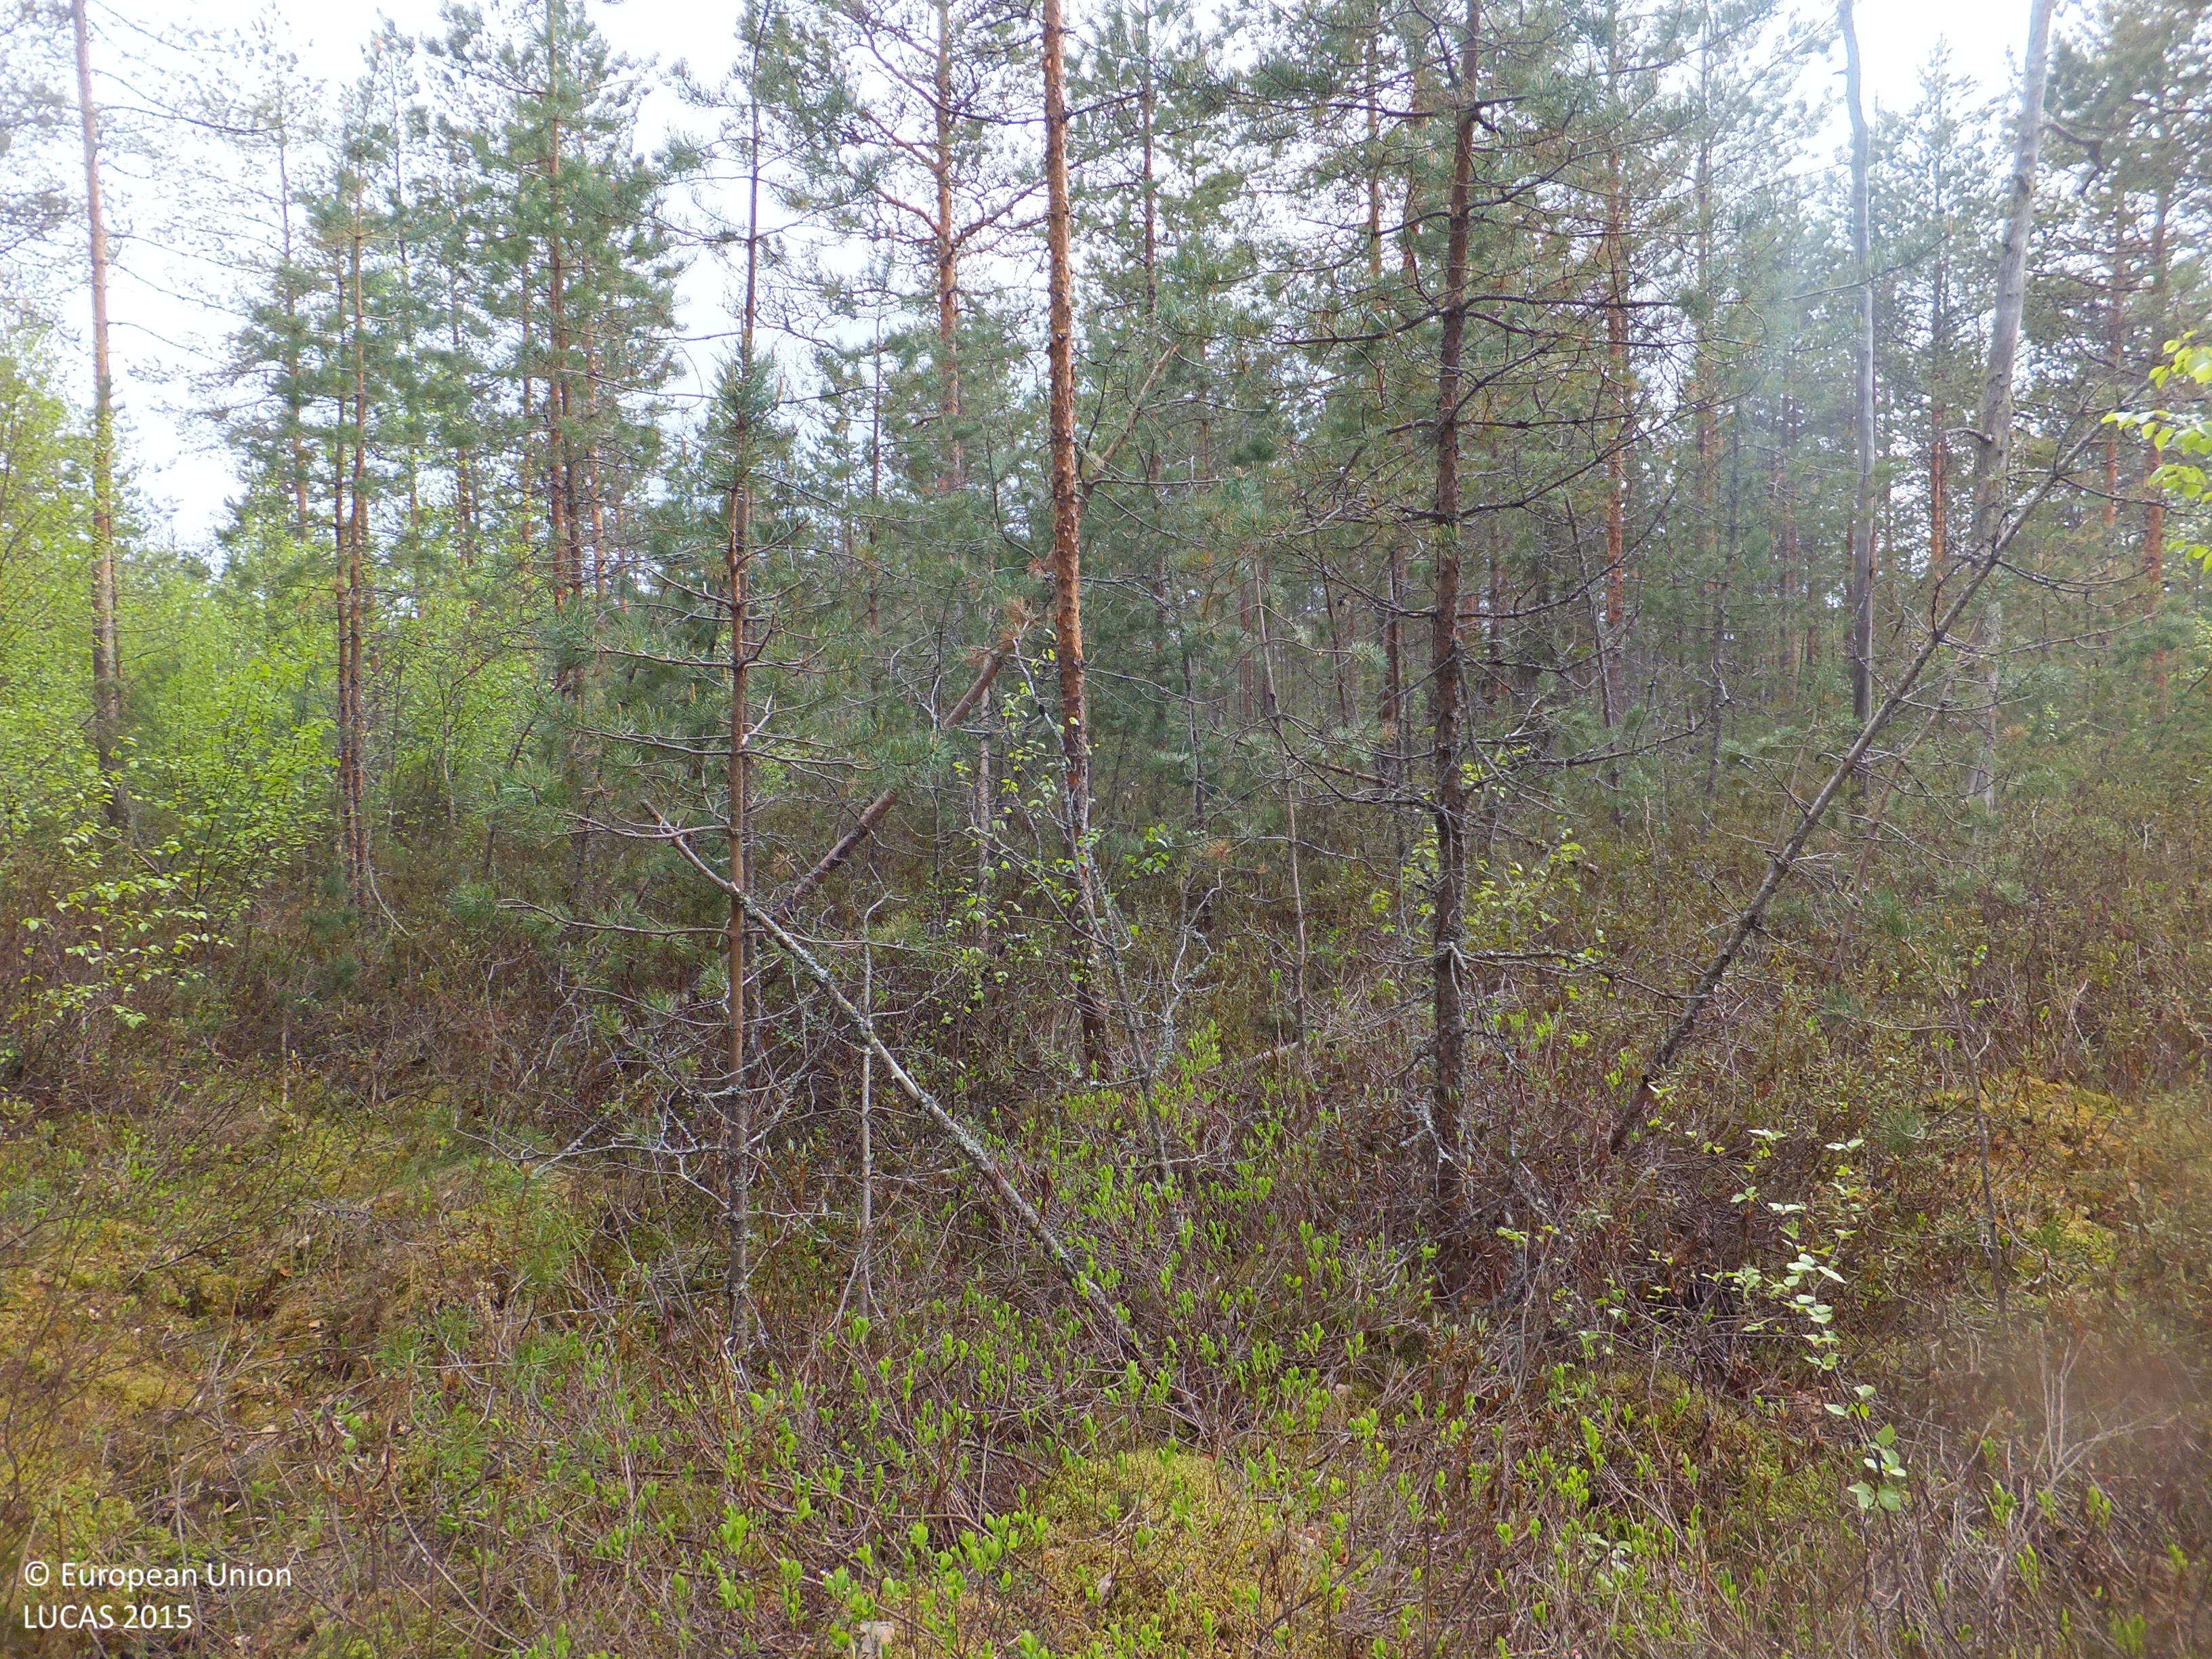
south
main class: Woodland
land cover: Pine dominated coniferous woodland
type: boreal forest
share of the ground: > 75 %
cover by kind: coniferous forest trees 80 %, shrubs 10 %, broadleaved forest trees 5 %, lichens and mosses 5 %
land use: Forestry
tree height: > 5 m
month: June
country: FI
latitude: 63.5470
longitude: 23.2365
